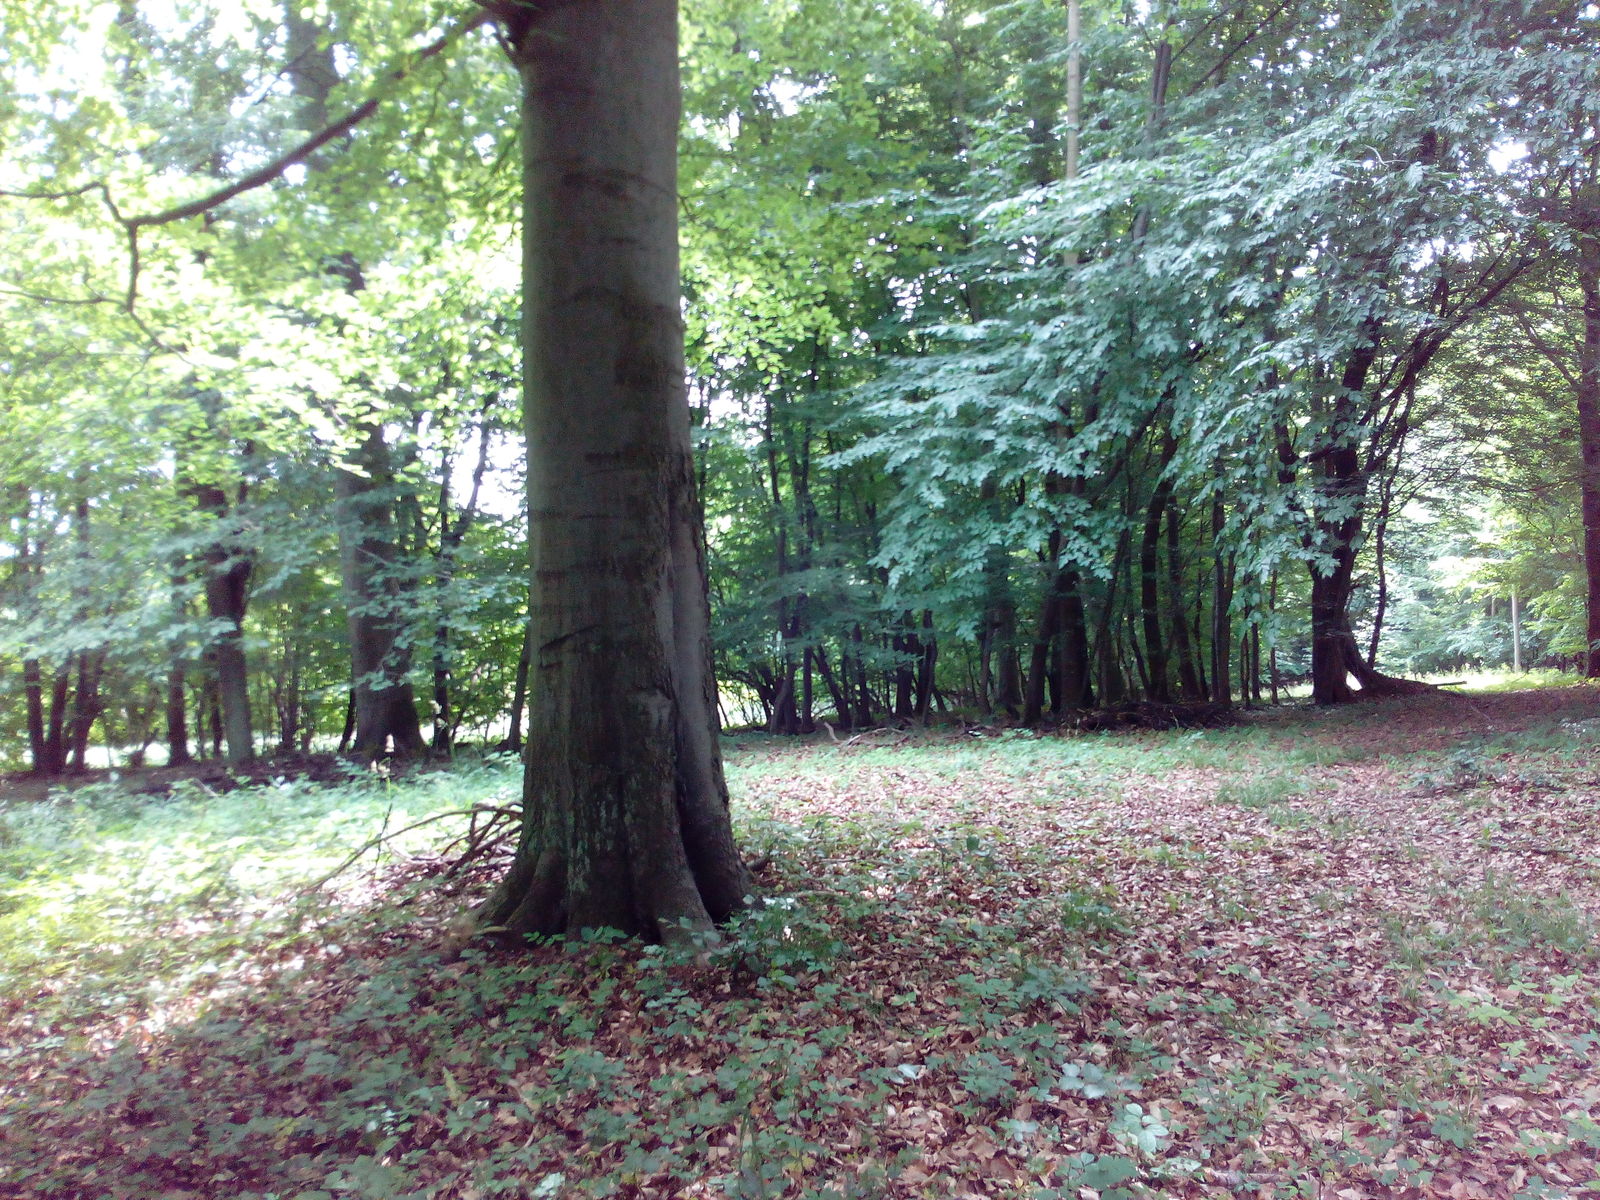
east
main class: Woodland
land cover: Broadleaved woodland
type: beech forest
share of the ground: > 75 %
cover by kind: broadleaved forest trees 90 %, herbaceous plants 10 %
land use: Forestry
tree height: > 5 m
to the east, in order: Broadleaved woodland; Grass margins; Common wheat; Grass margins; Broadleaved woodland; Shrubland with sparse tree cover; Broadleaved woodland
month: June
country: DE
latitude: 51.3304
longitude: 11.0187
